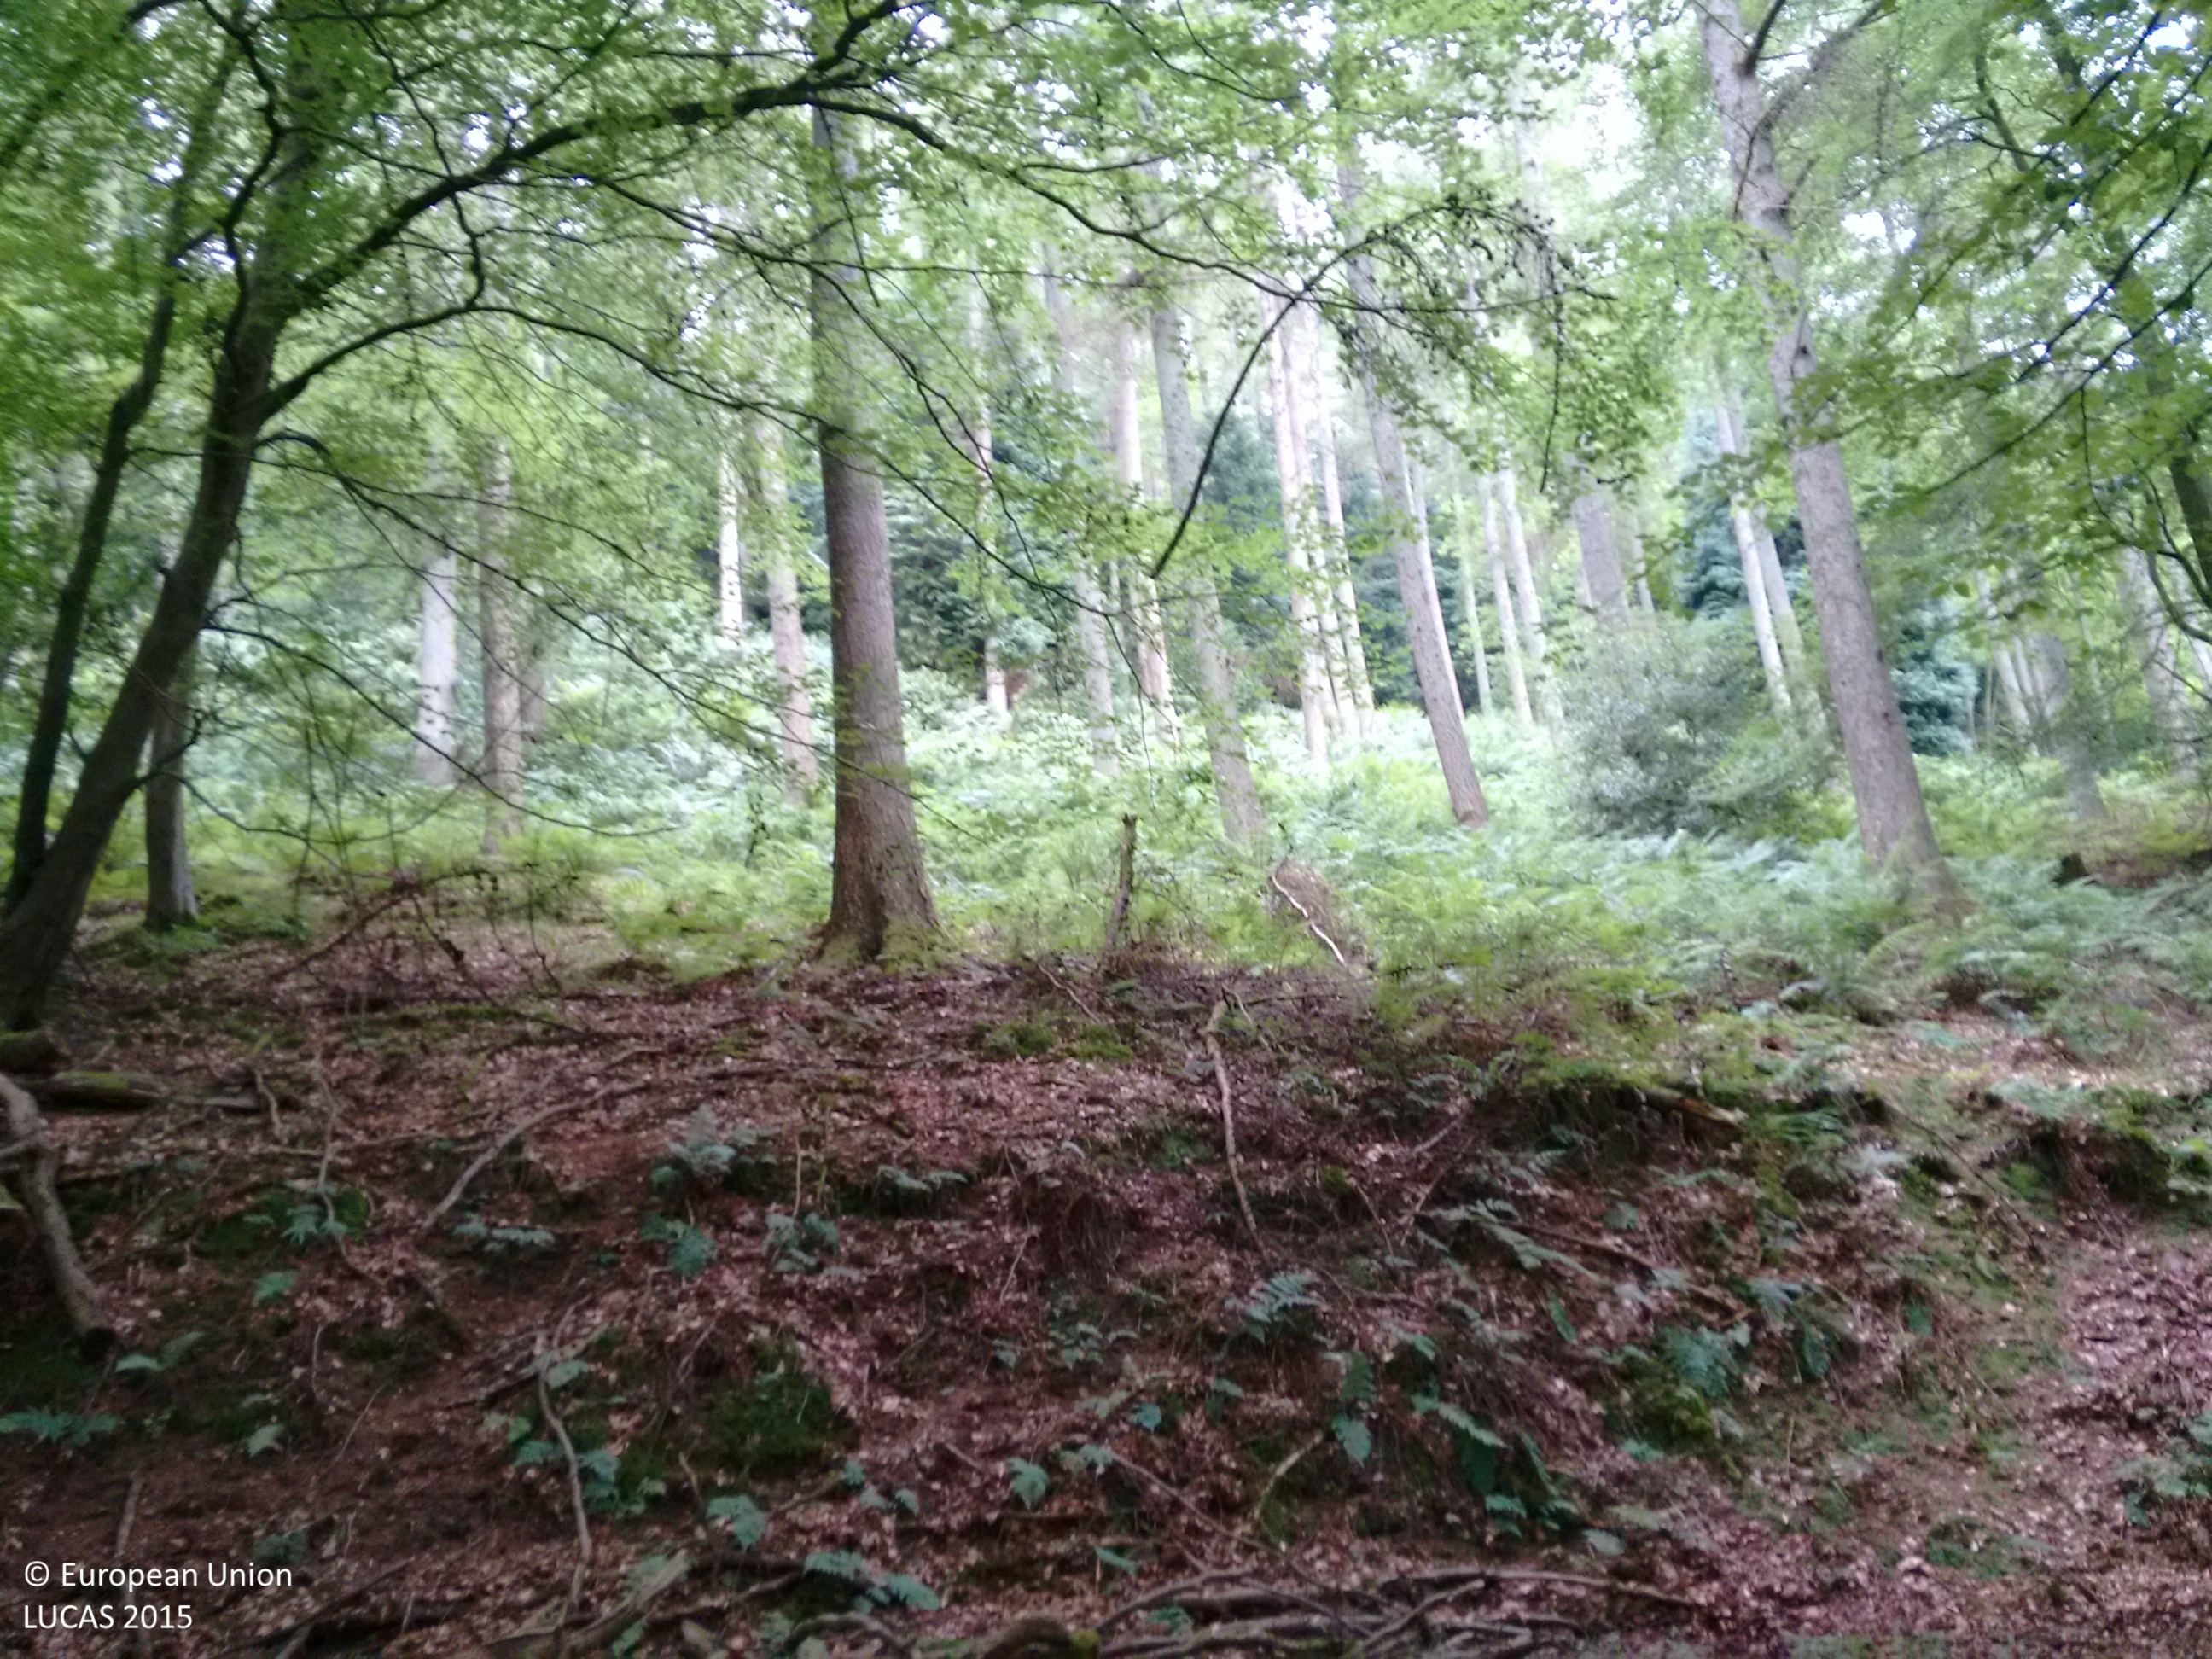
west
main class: Woodland
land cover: Broadleaved woodland
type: mesophytic deciduous forest
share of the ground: > 75 %
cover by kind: broadleaved forest trees 100 %
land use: Semi-natural and natural areas not in use
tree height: > 5 m
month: July
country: GB
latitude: 55.0338
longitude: -3.6487
